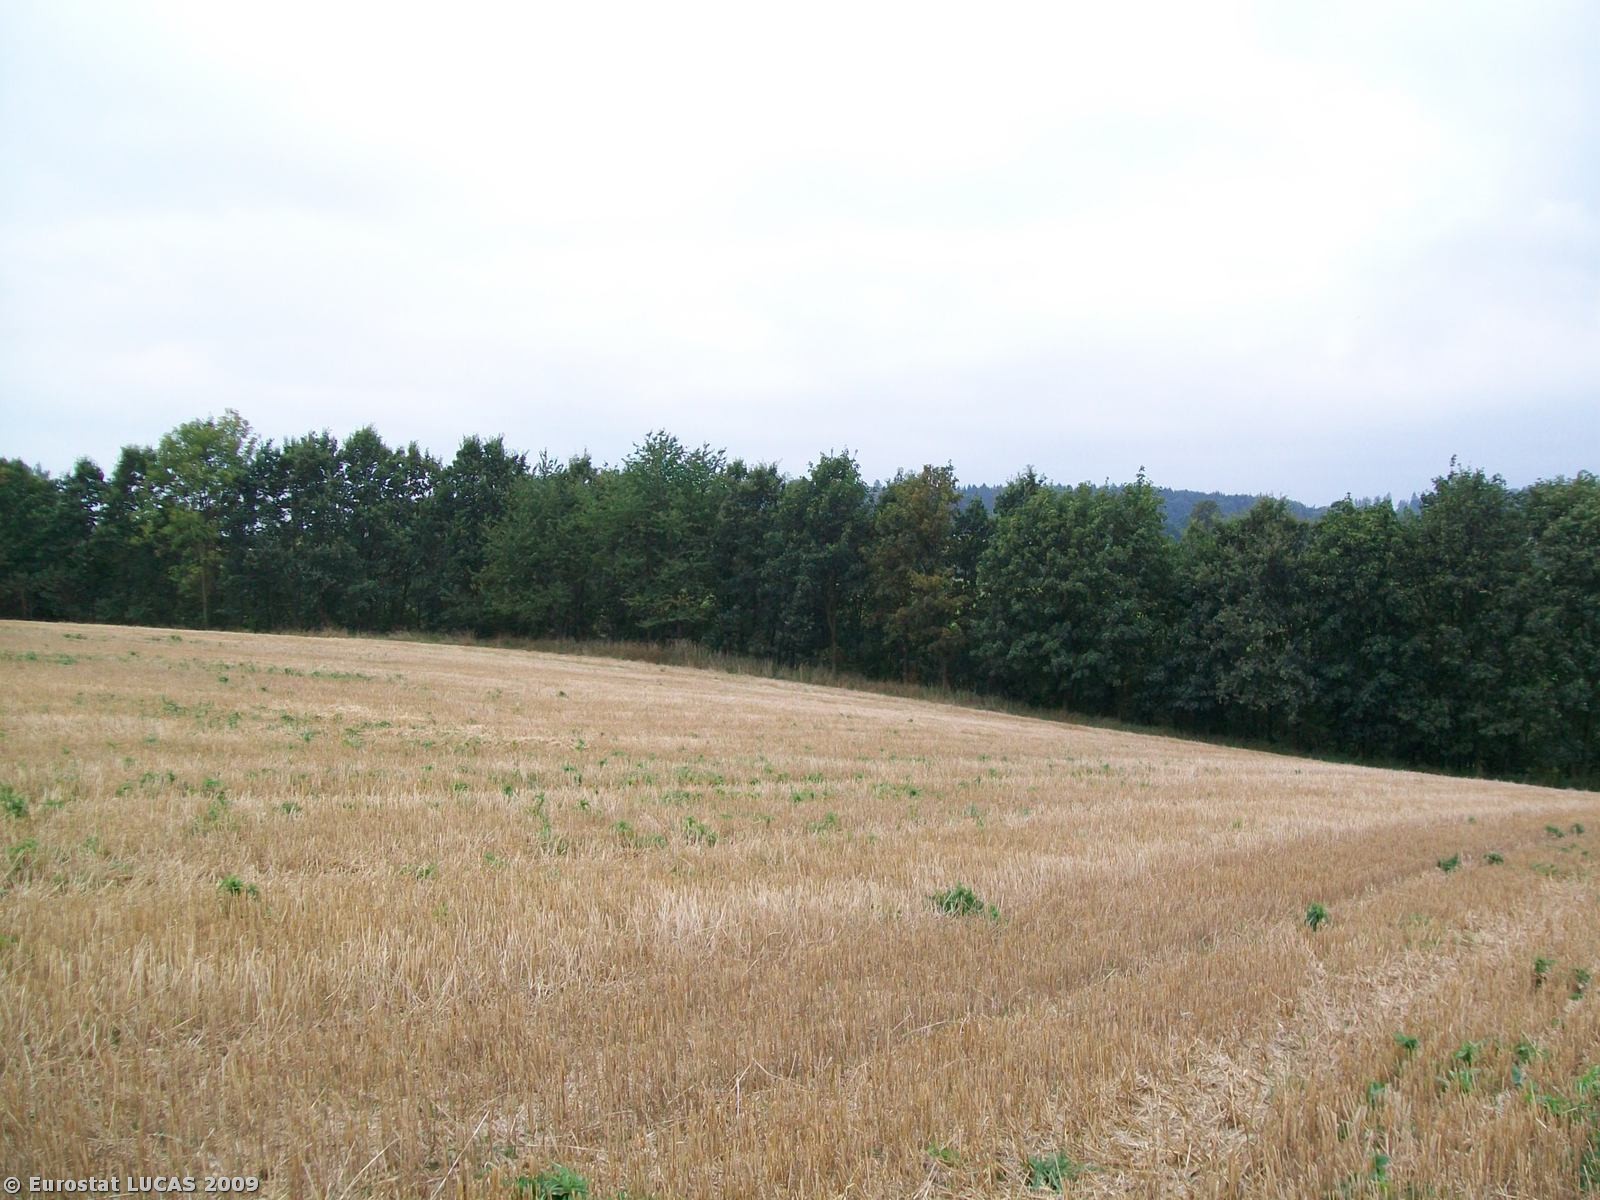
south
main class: Cropland
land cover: Common wheat
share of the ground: < 10 %
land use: Agriculture (excluding fallow land and kitchen gardens)
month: September
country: PL
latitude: 50.4954
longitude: 16.6480
